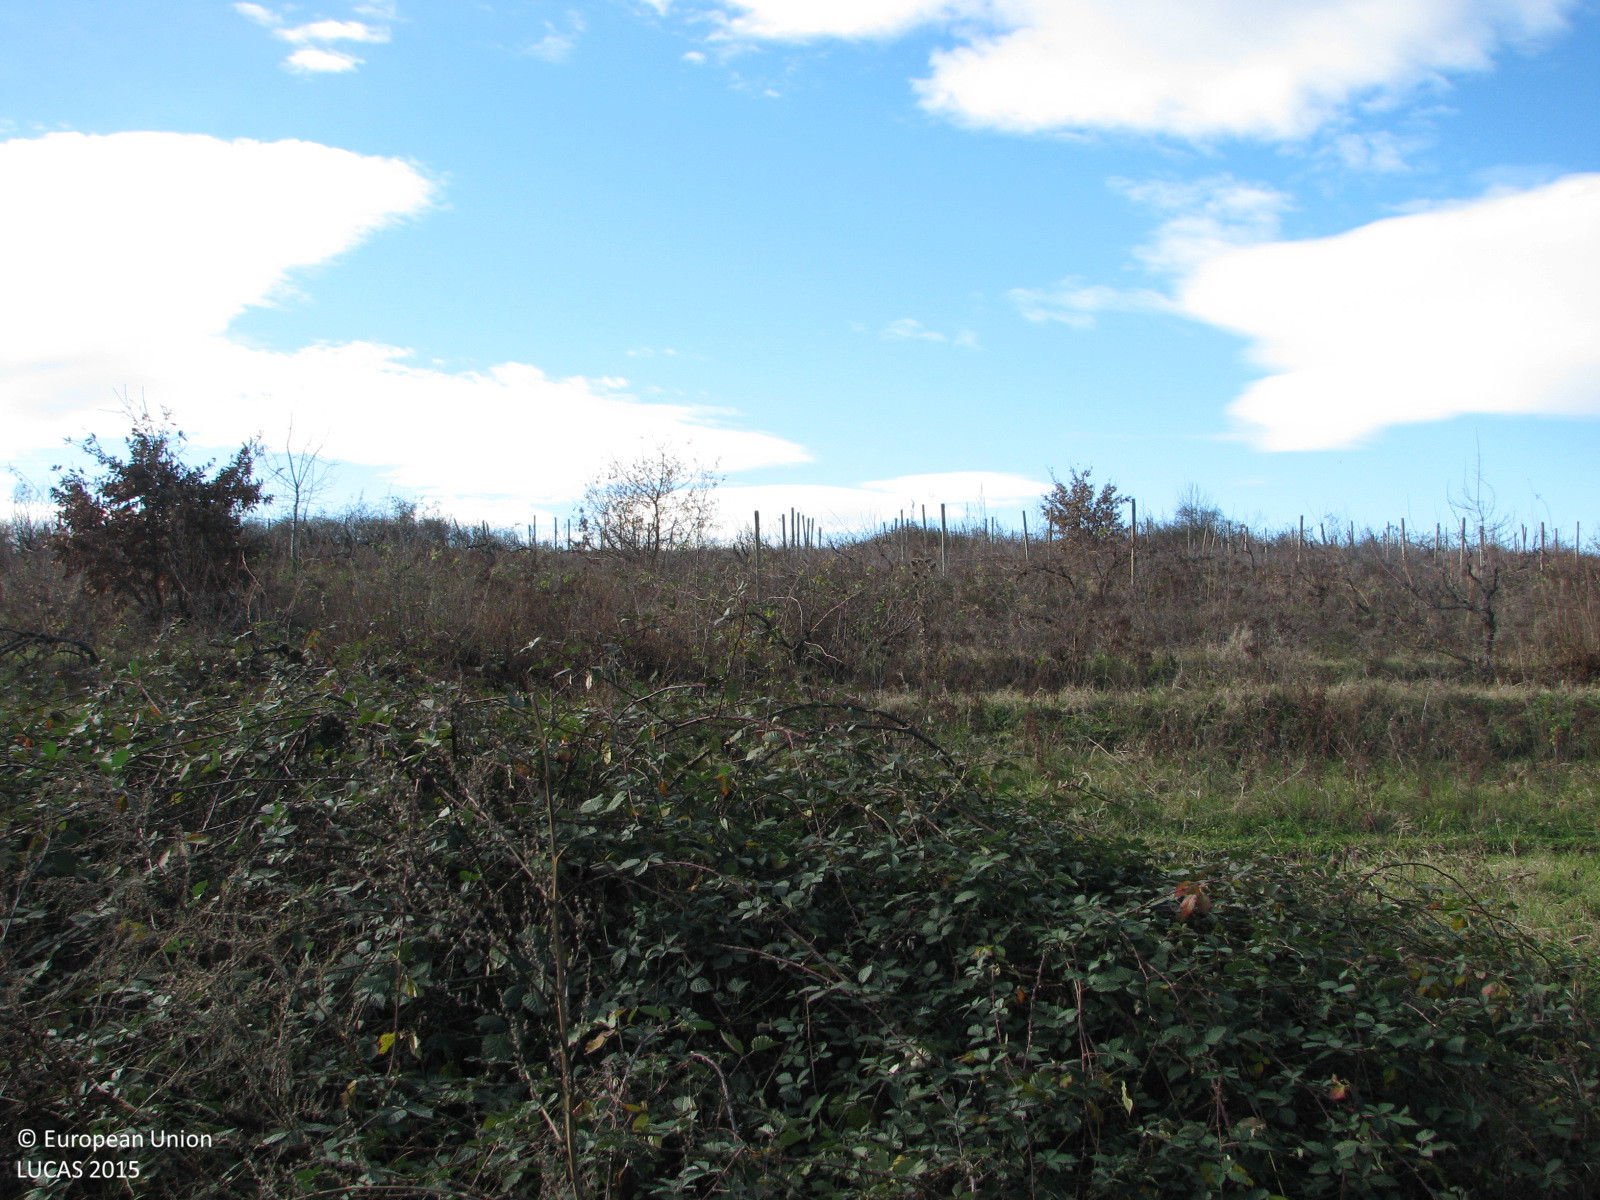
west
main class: Woodland
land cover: Broadleaved woodland
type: mesophytic deciduous forest
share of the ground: 50 - 75 %
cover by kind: broadleaved forest trees 55 %, shrubs 35 %, herbaceous plants 10 %
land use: Semi-natural and natural areas not in use
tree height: < 5 m
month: November
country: BG
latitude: 42.5206
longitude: 24.7480
